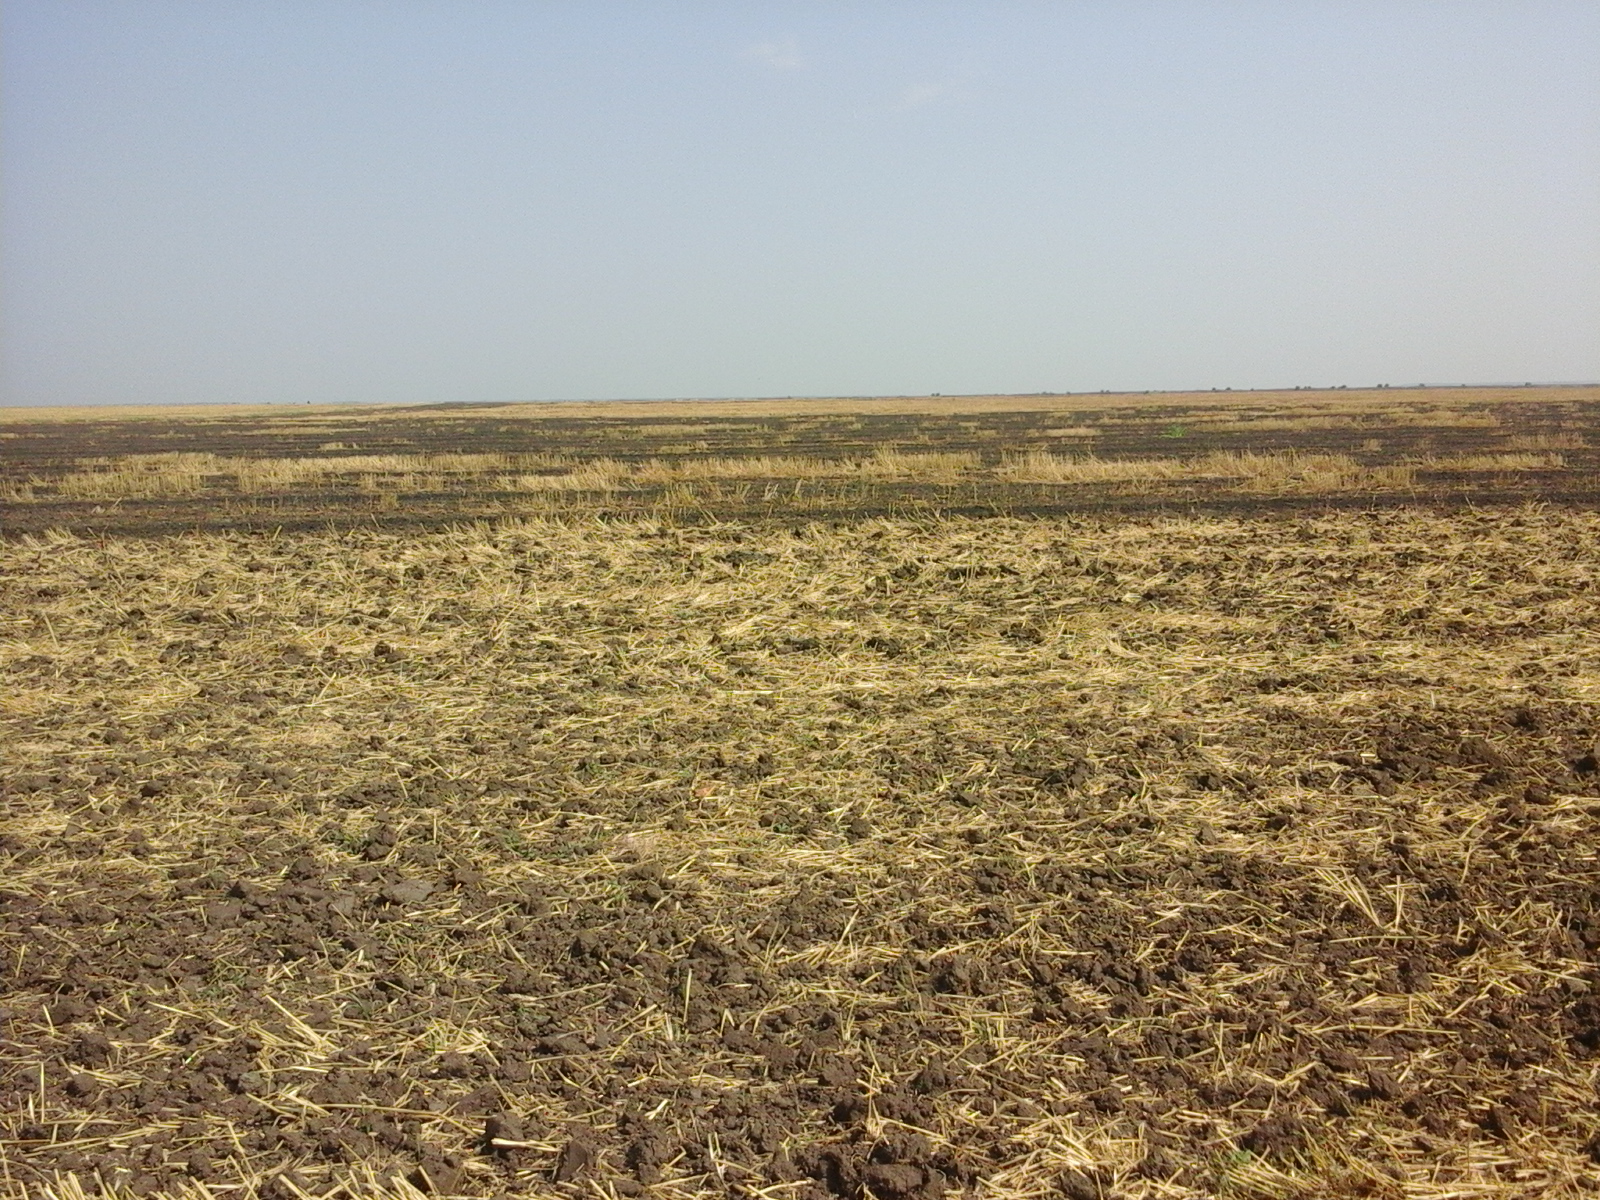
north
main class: Cropland
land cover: Common wheat
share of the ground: 50 - 75 %
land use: Agriculture (excluding fallow land and kitchen gardens)
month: August
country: RO
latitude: 44.0429
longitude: 23.5409
